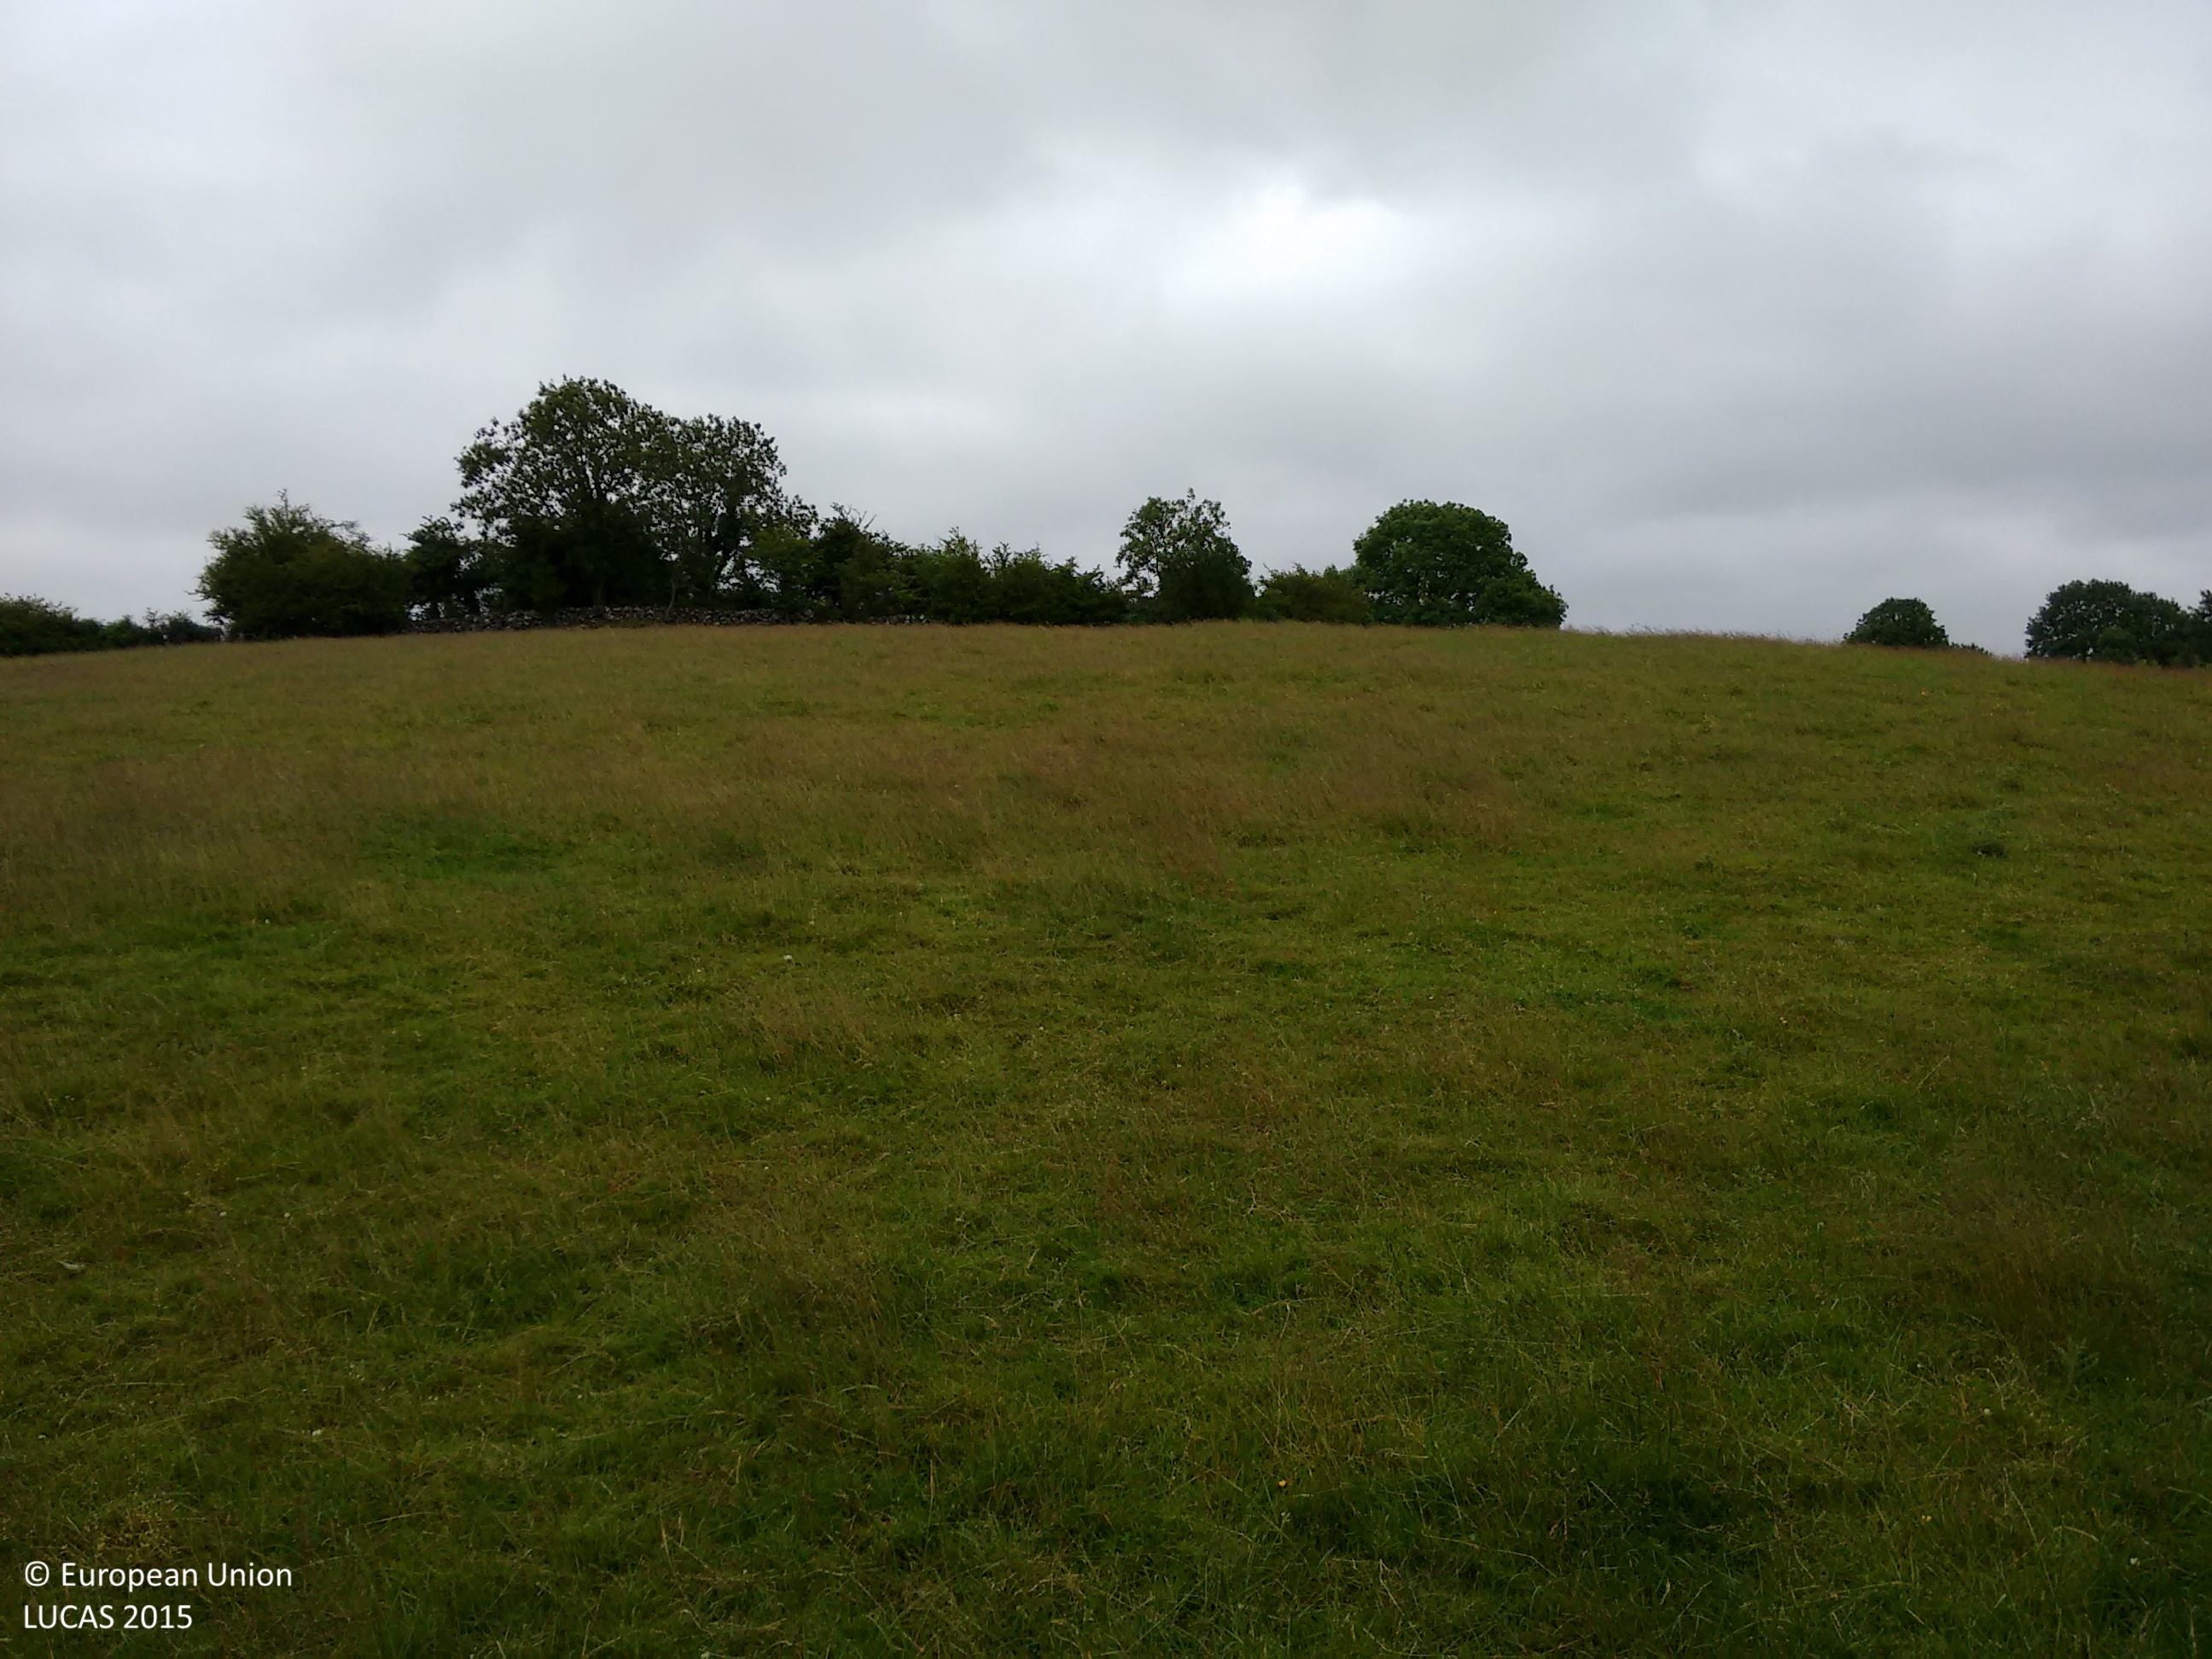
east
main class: Grassland
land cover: Grassland without tree/shrub cover
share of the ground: > 75 %
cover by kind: herbaceous plants 100 %
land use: Agriculture (excluding fallow land and kitchen gardens)
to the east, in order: Grassland without tree/shrub cover; Broadleaved woodland; Fences; Dry stone walls; Broadleaved woodland; Paved roads, cycling and walking lanes; Dry stone walls; Broadleaved woodland; Grassland without tree/shrub cover; Broadleaved woodland; Shrubland without tree cover; Grassland without tree/shrub cover; Broadleaved woodland
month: June
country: IE
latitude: 53.4497
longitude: -8.0504
